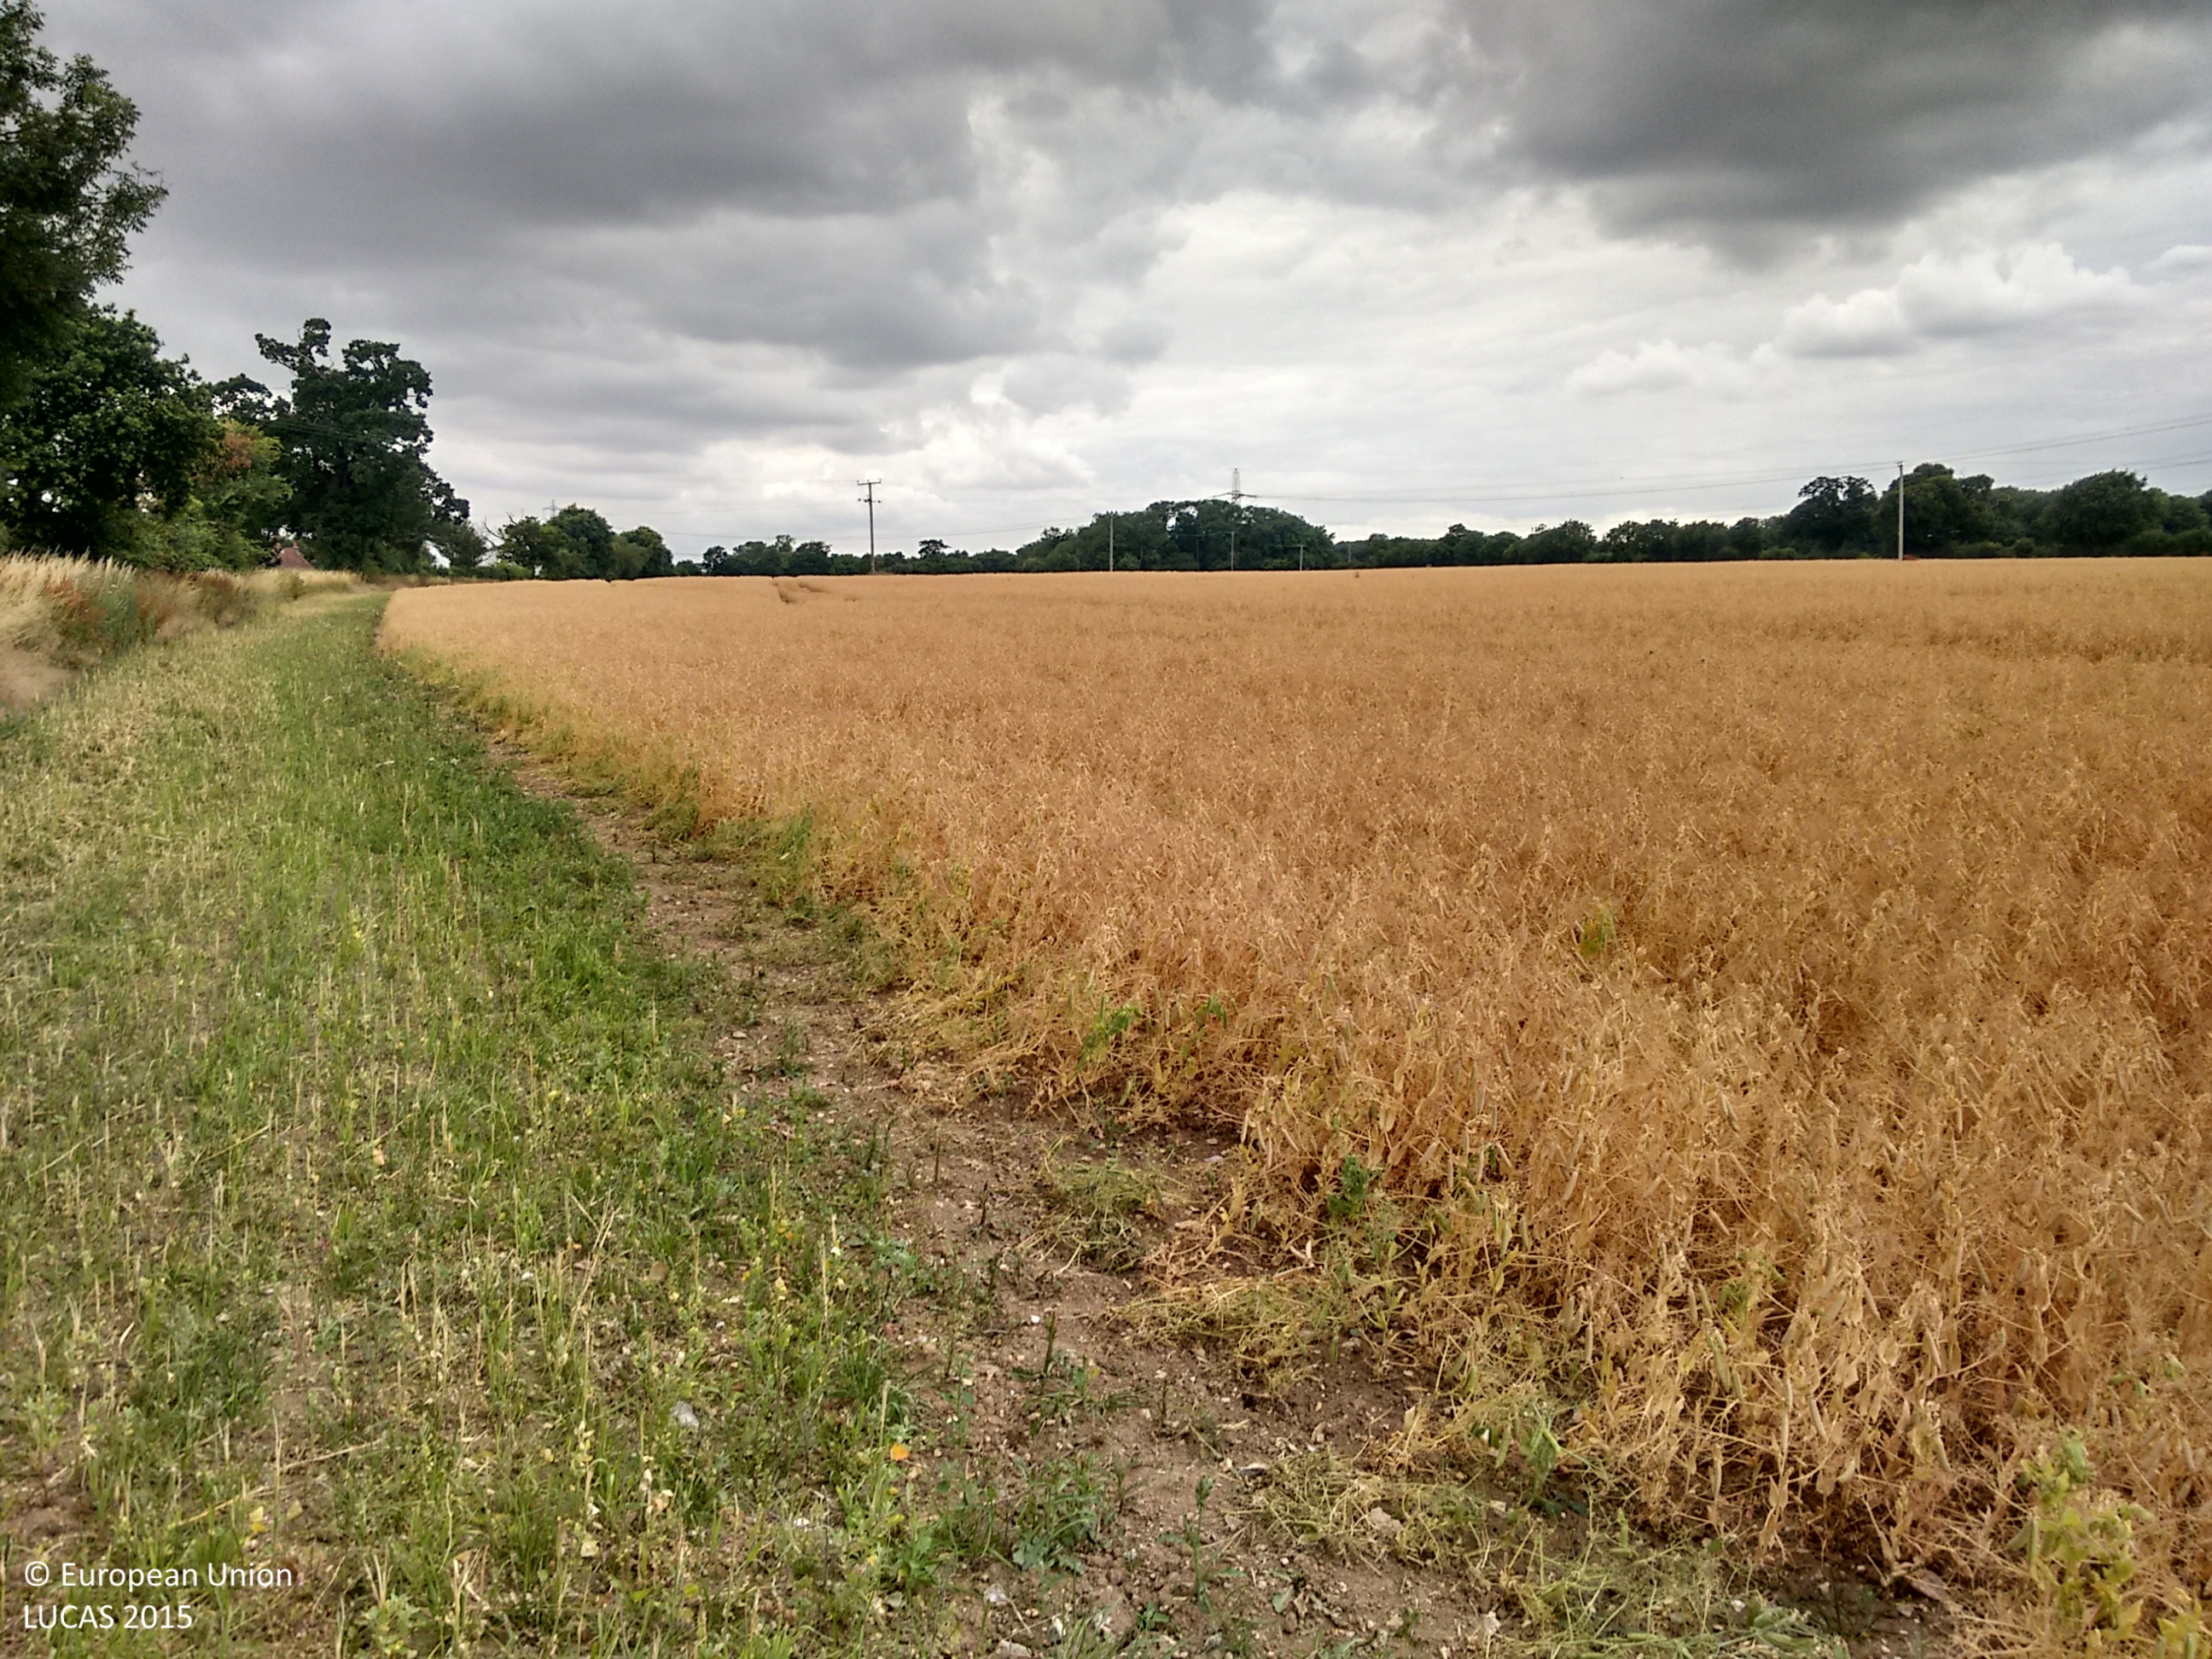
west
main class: Grassland
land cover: Spontaneously vegetated surfaces
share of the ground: 25 - 50 %
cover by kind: herbaceous plants 100 %
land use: Fallow land
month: July
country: GB
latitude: 51.8193
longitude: 0.5575
